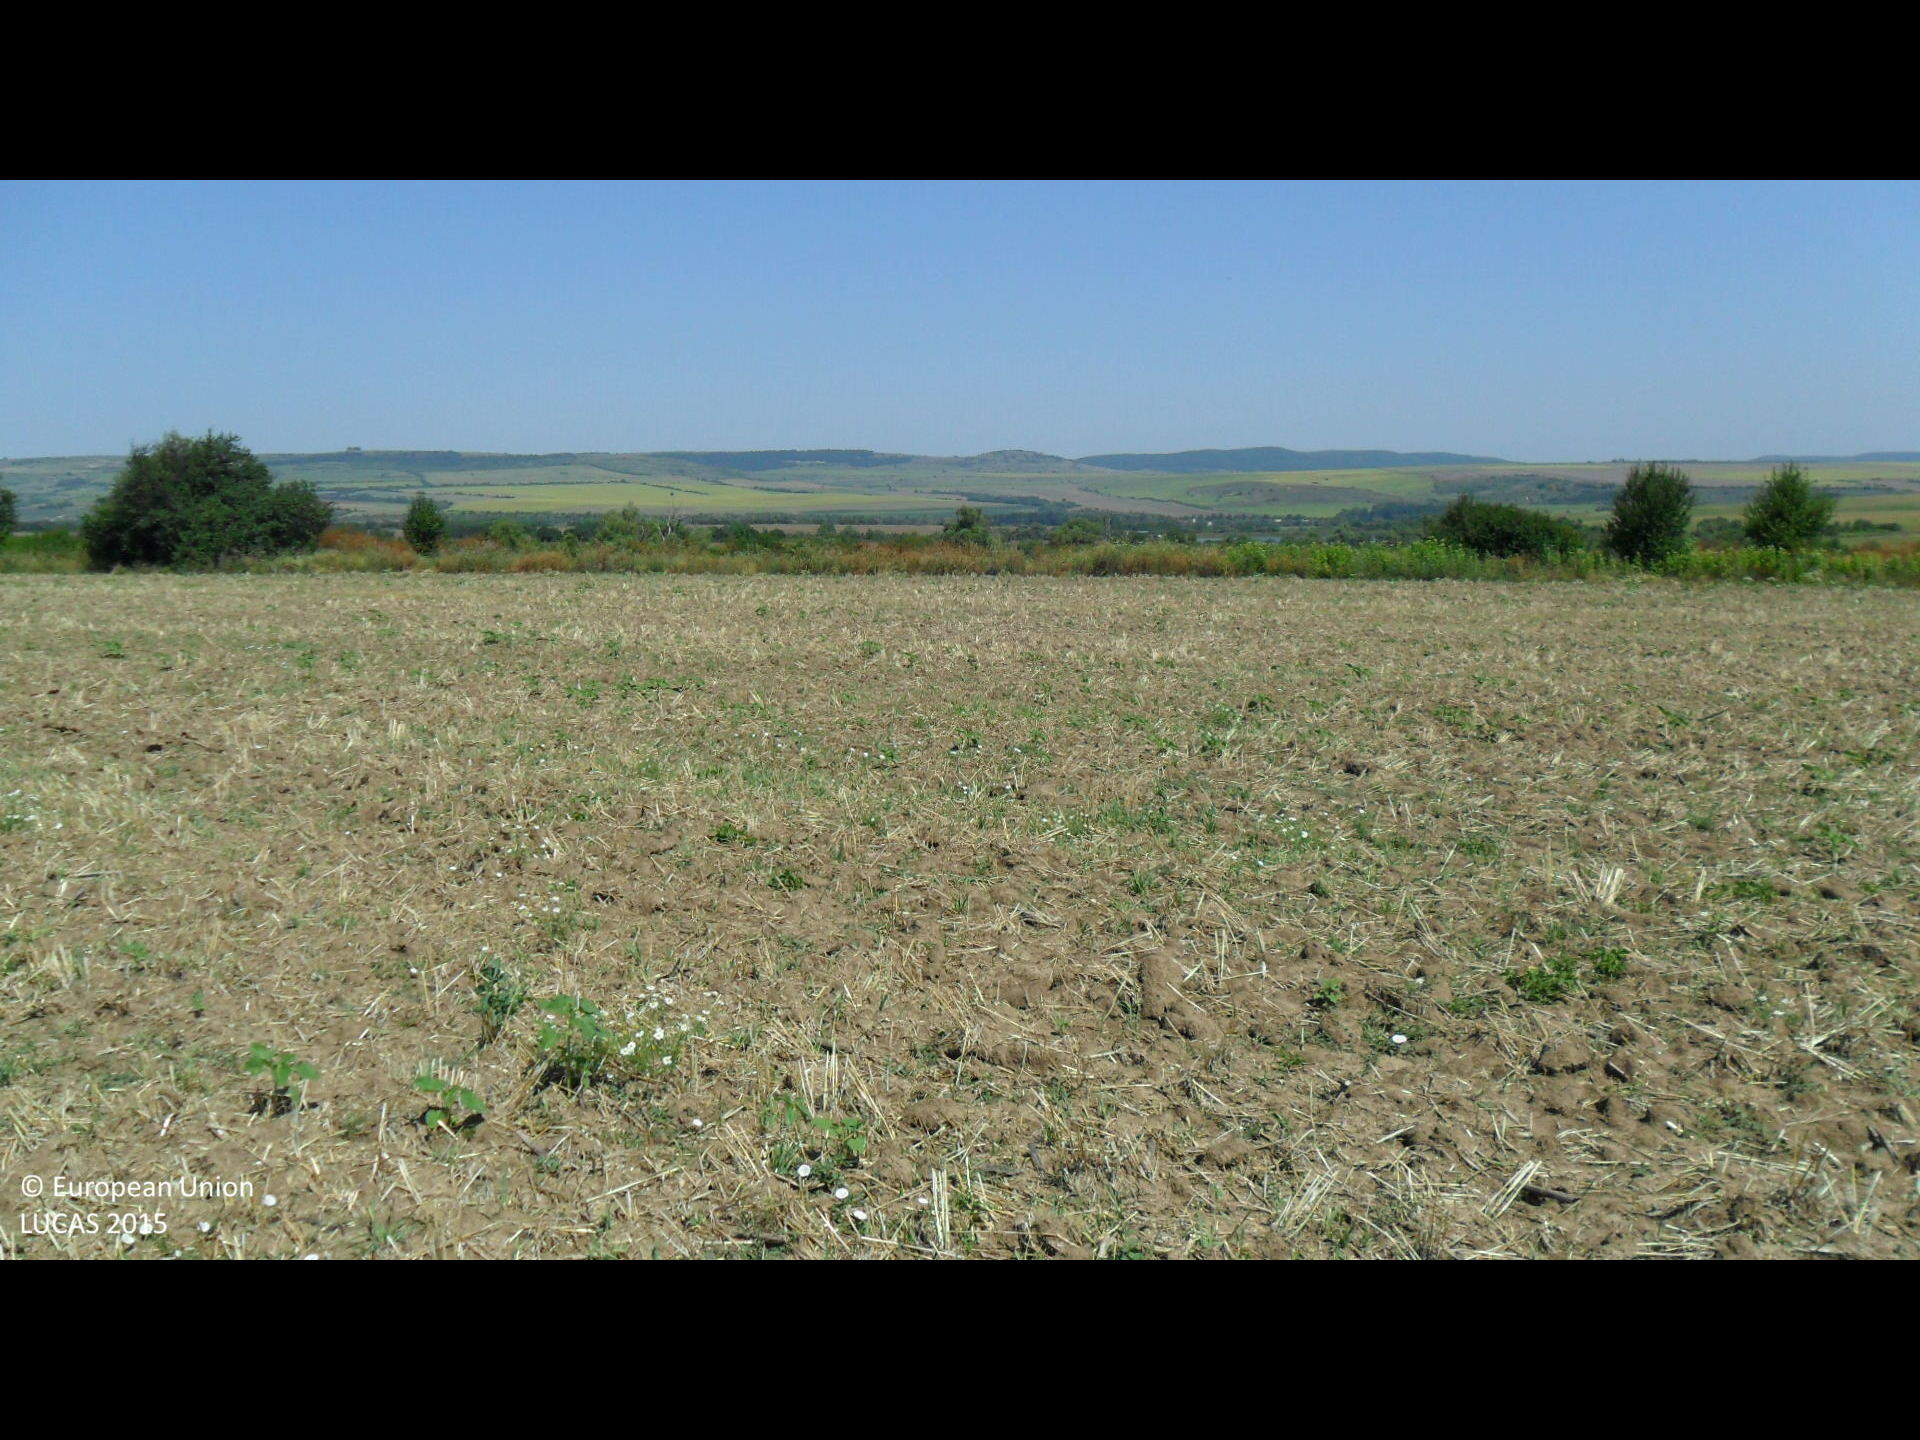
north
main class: Cropland
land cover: Barley
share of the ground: 10 - 25 %
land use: Agriculture (excluding fallow land and kitchen gardens)
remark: Harvested field
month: August
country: BG
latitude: 43.3341
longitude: 26.1403
